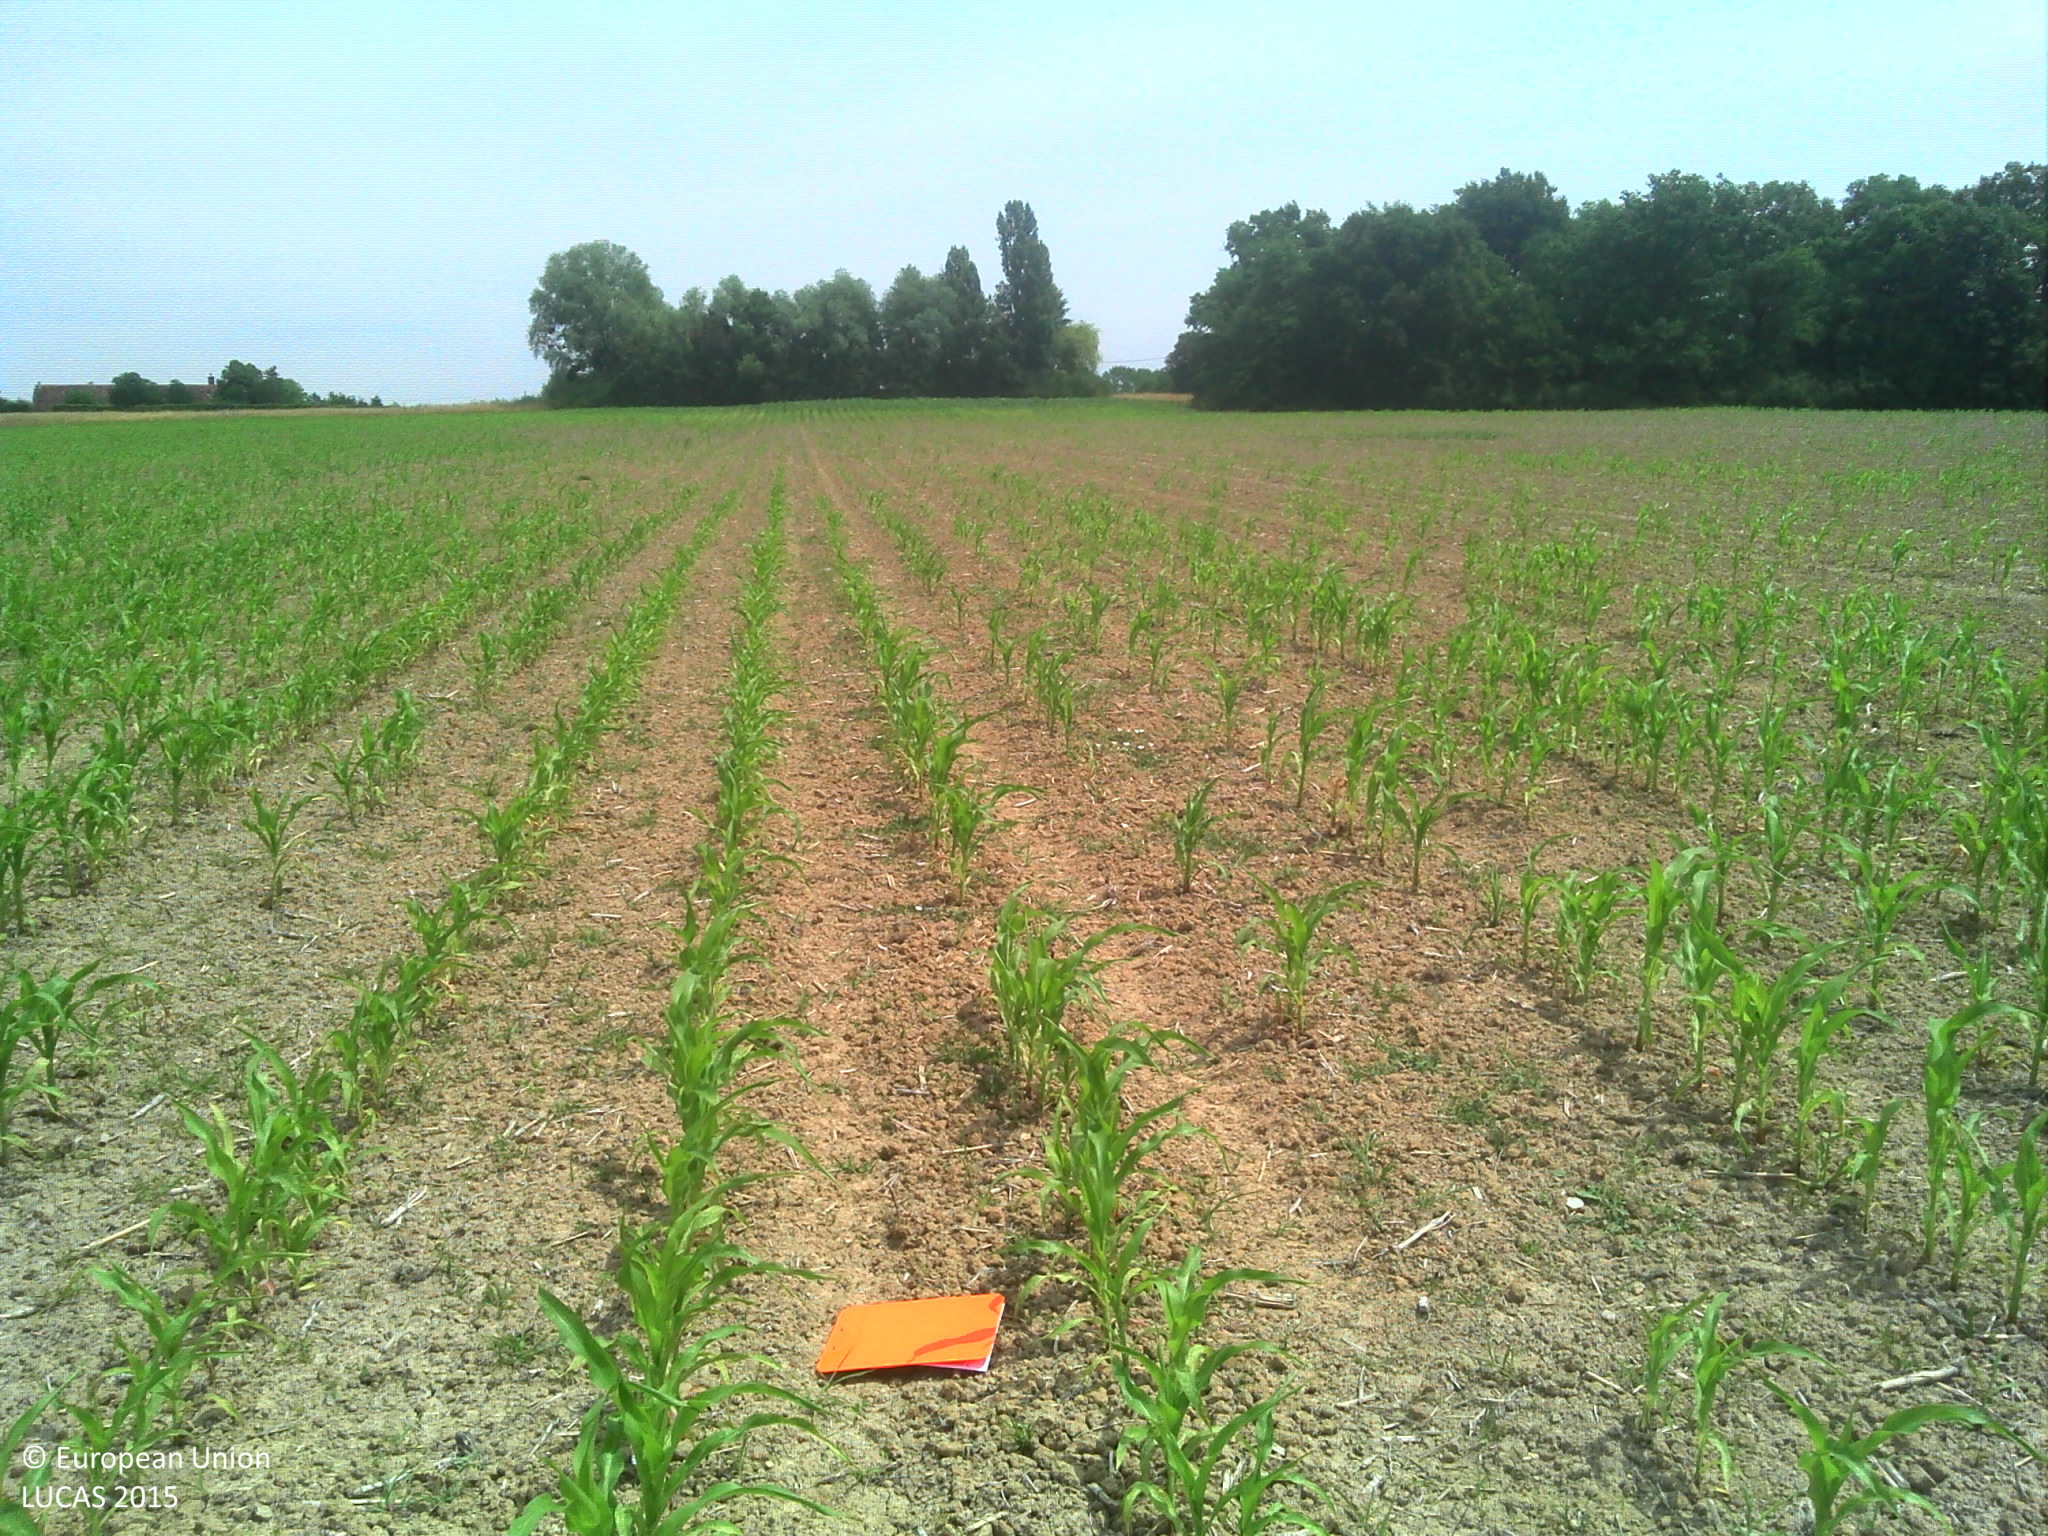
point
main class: Cropland
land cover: Maize
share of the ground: 25 - 50 %
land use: Agriculture (excluding fallow land and kitchen gardens)
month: June
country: FR
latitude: 47.4667
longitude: 1.3485
